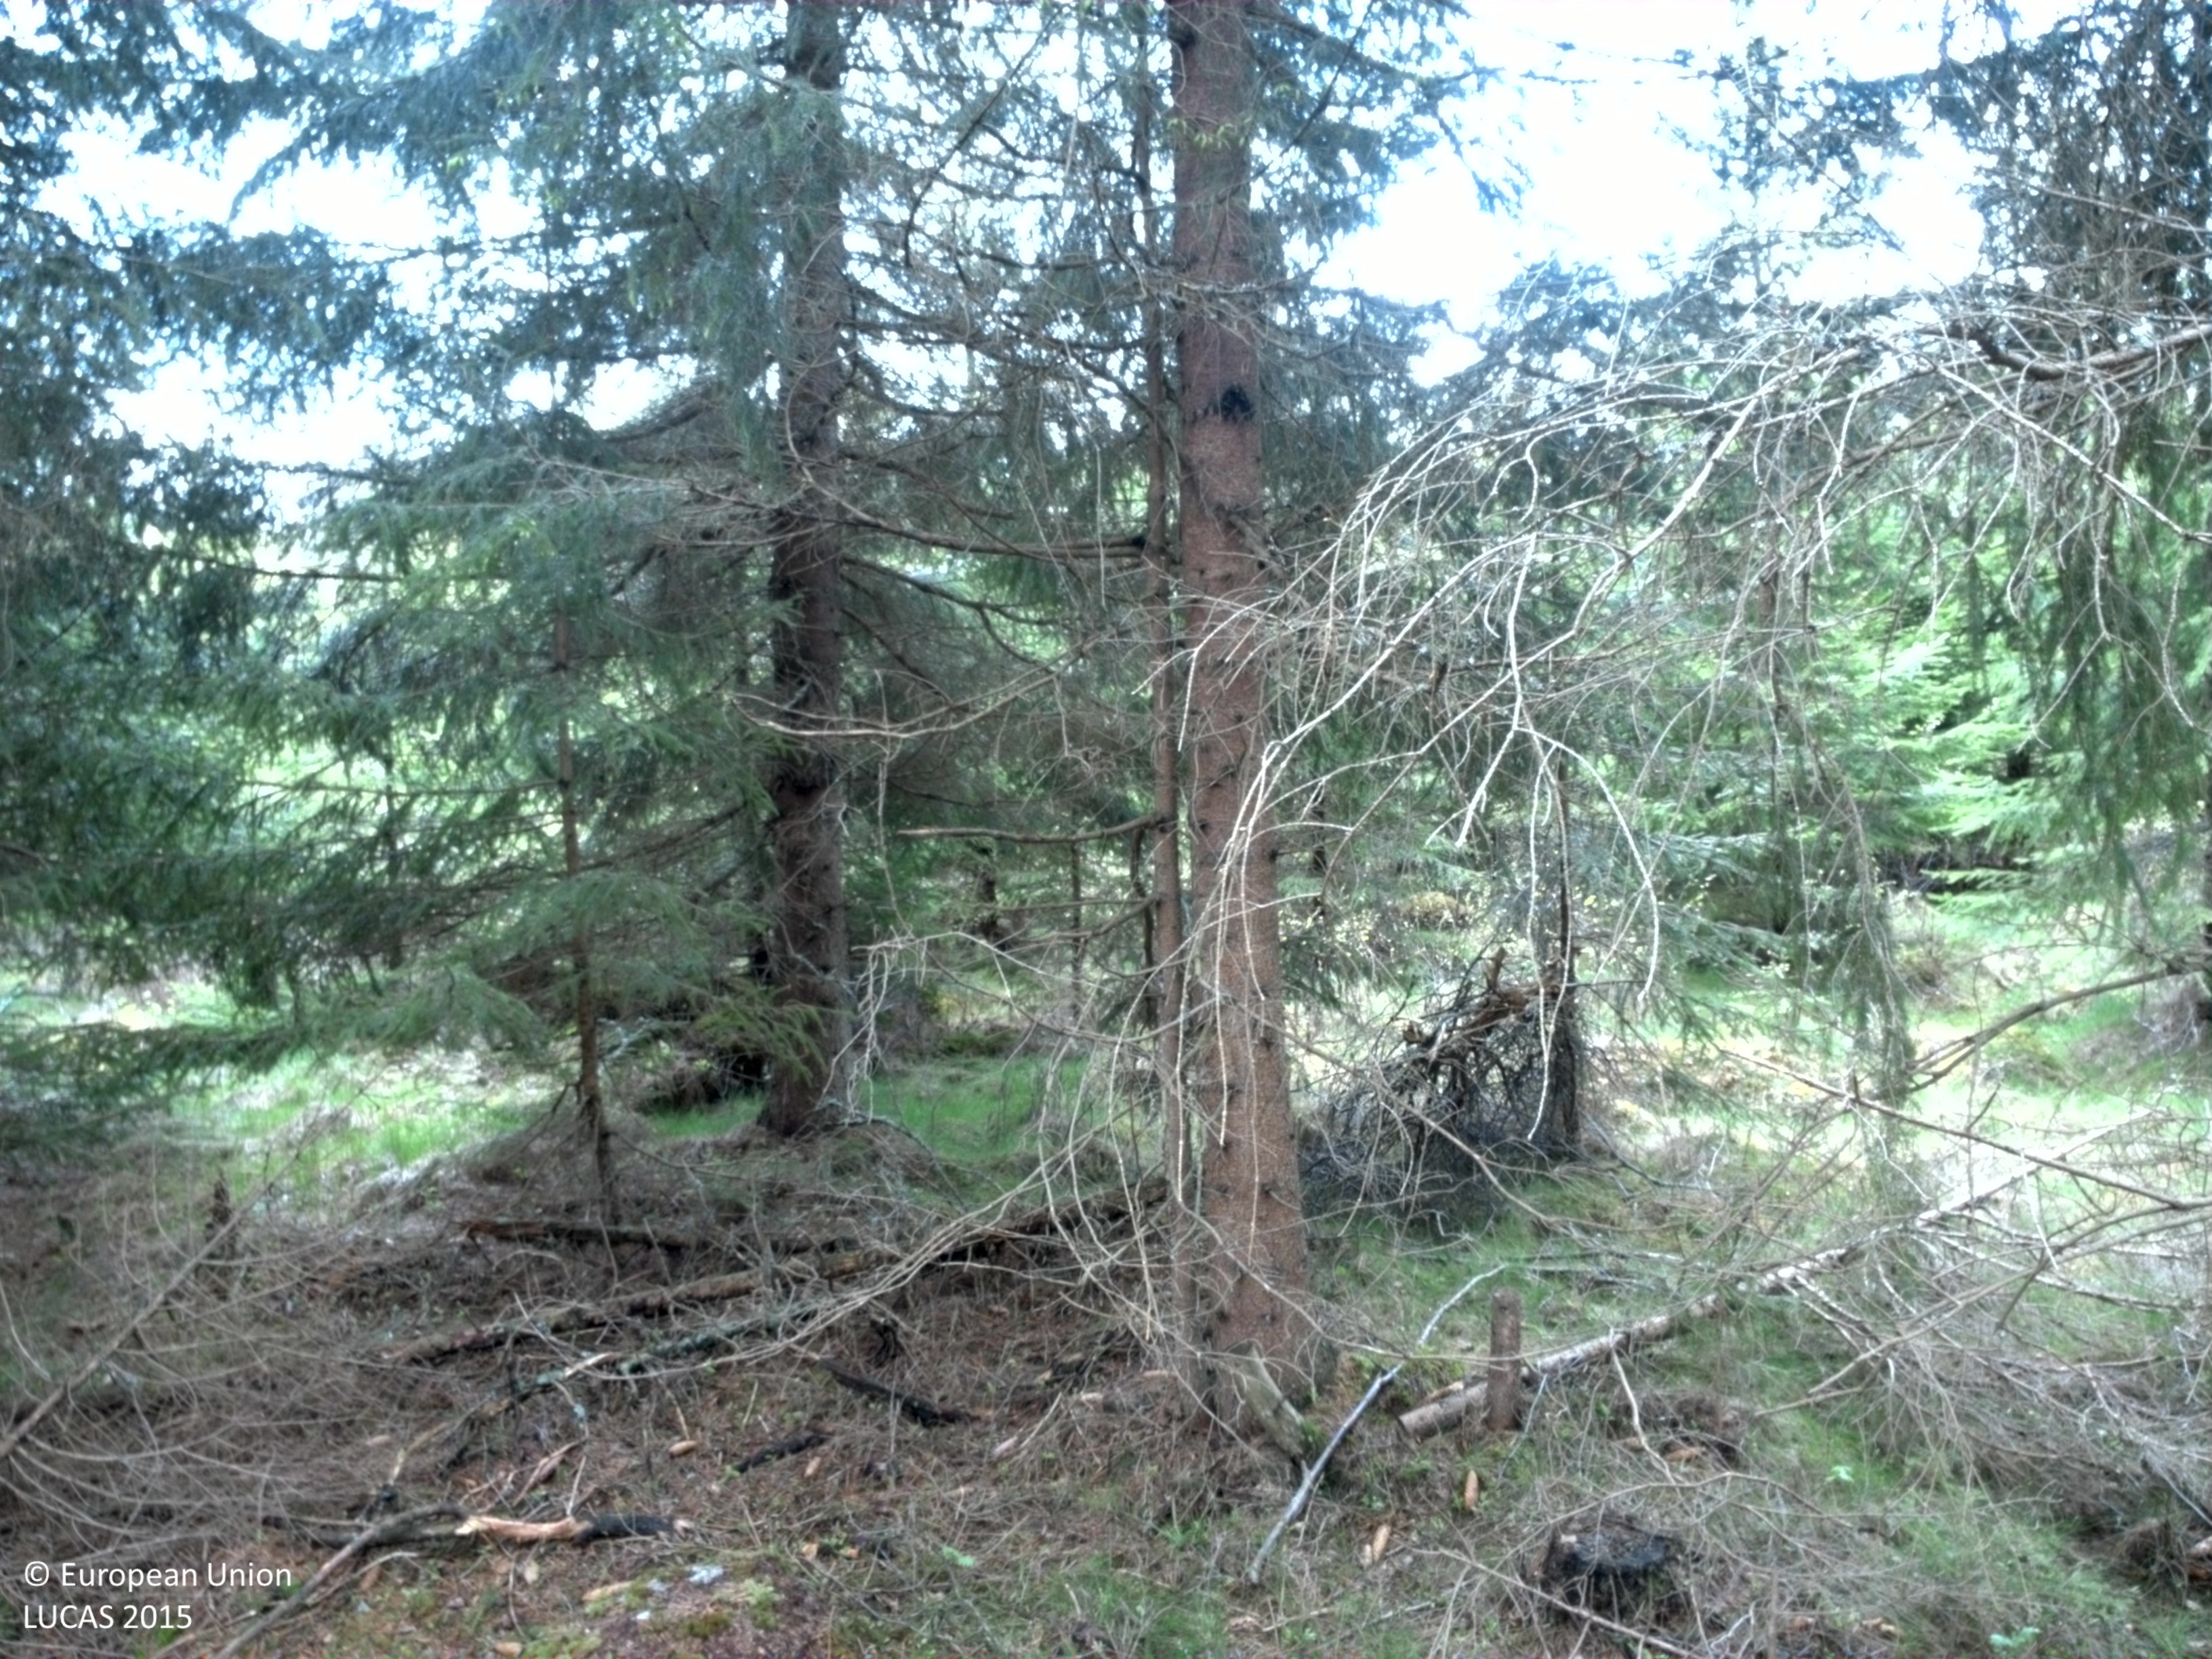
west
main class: Woodland
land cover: Spruce dominated coniferous woodland
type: boreal forest
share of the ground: 50 - 75 %
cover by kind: coniferous forest trees 50 %, herbaceous plants 15 %, broadleaved forest trees 10 %, lichens and mosses 10 %, unconsolidated bare surface 10 %, shrubs 5 %
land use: Forestry
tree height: > 5 m
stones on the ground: < 10 %
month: May
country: SE
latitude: 56.8075
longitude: 15.0913
